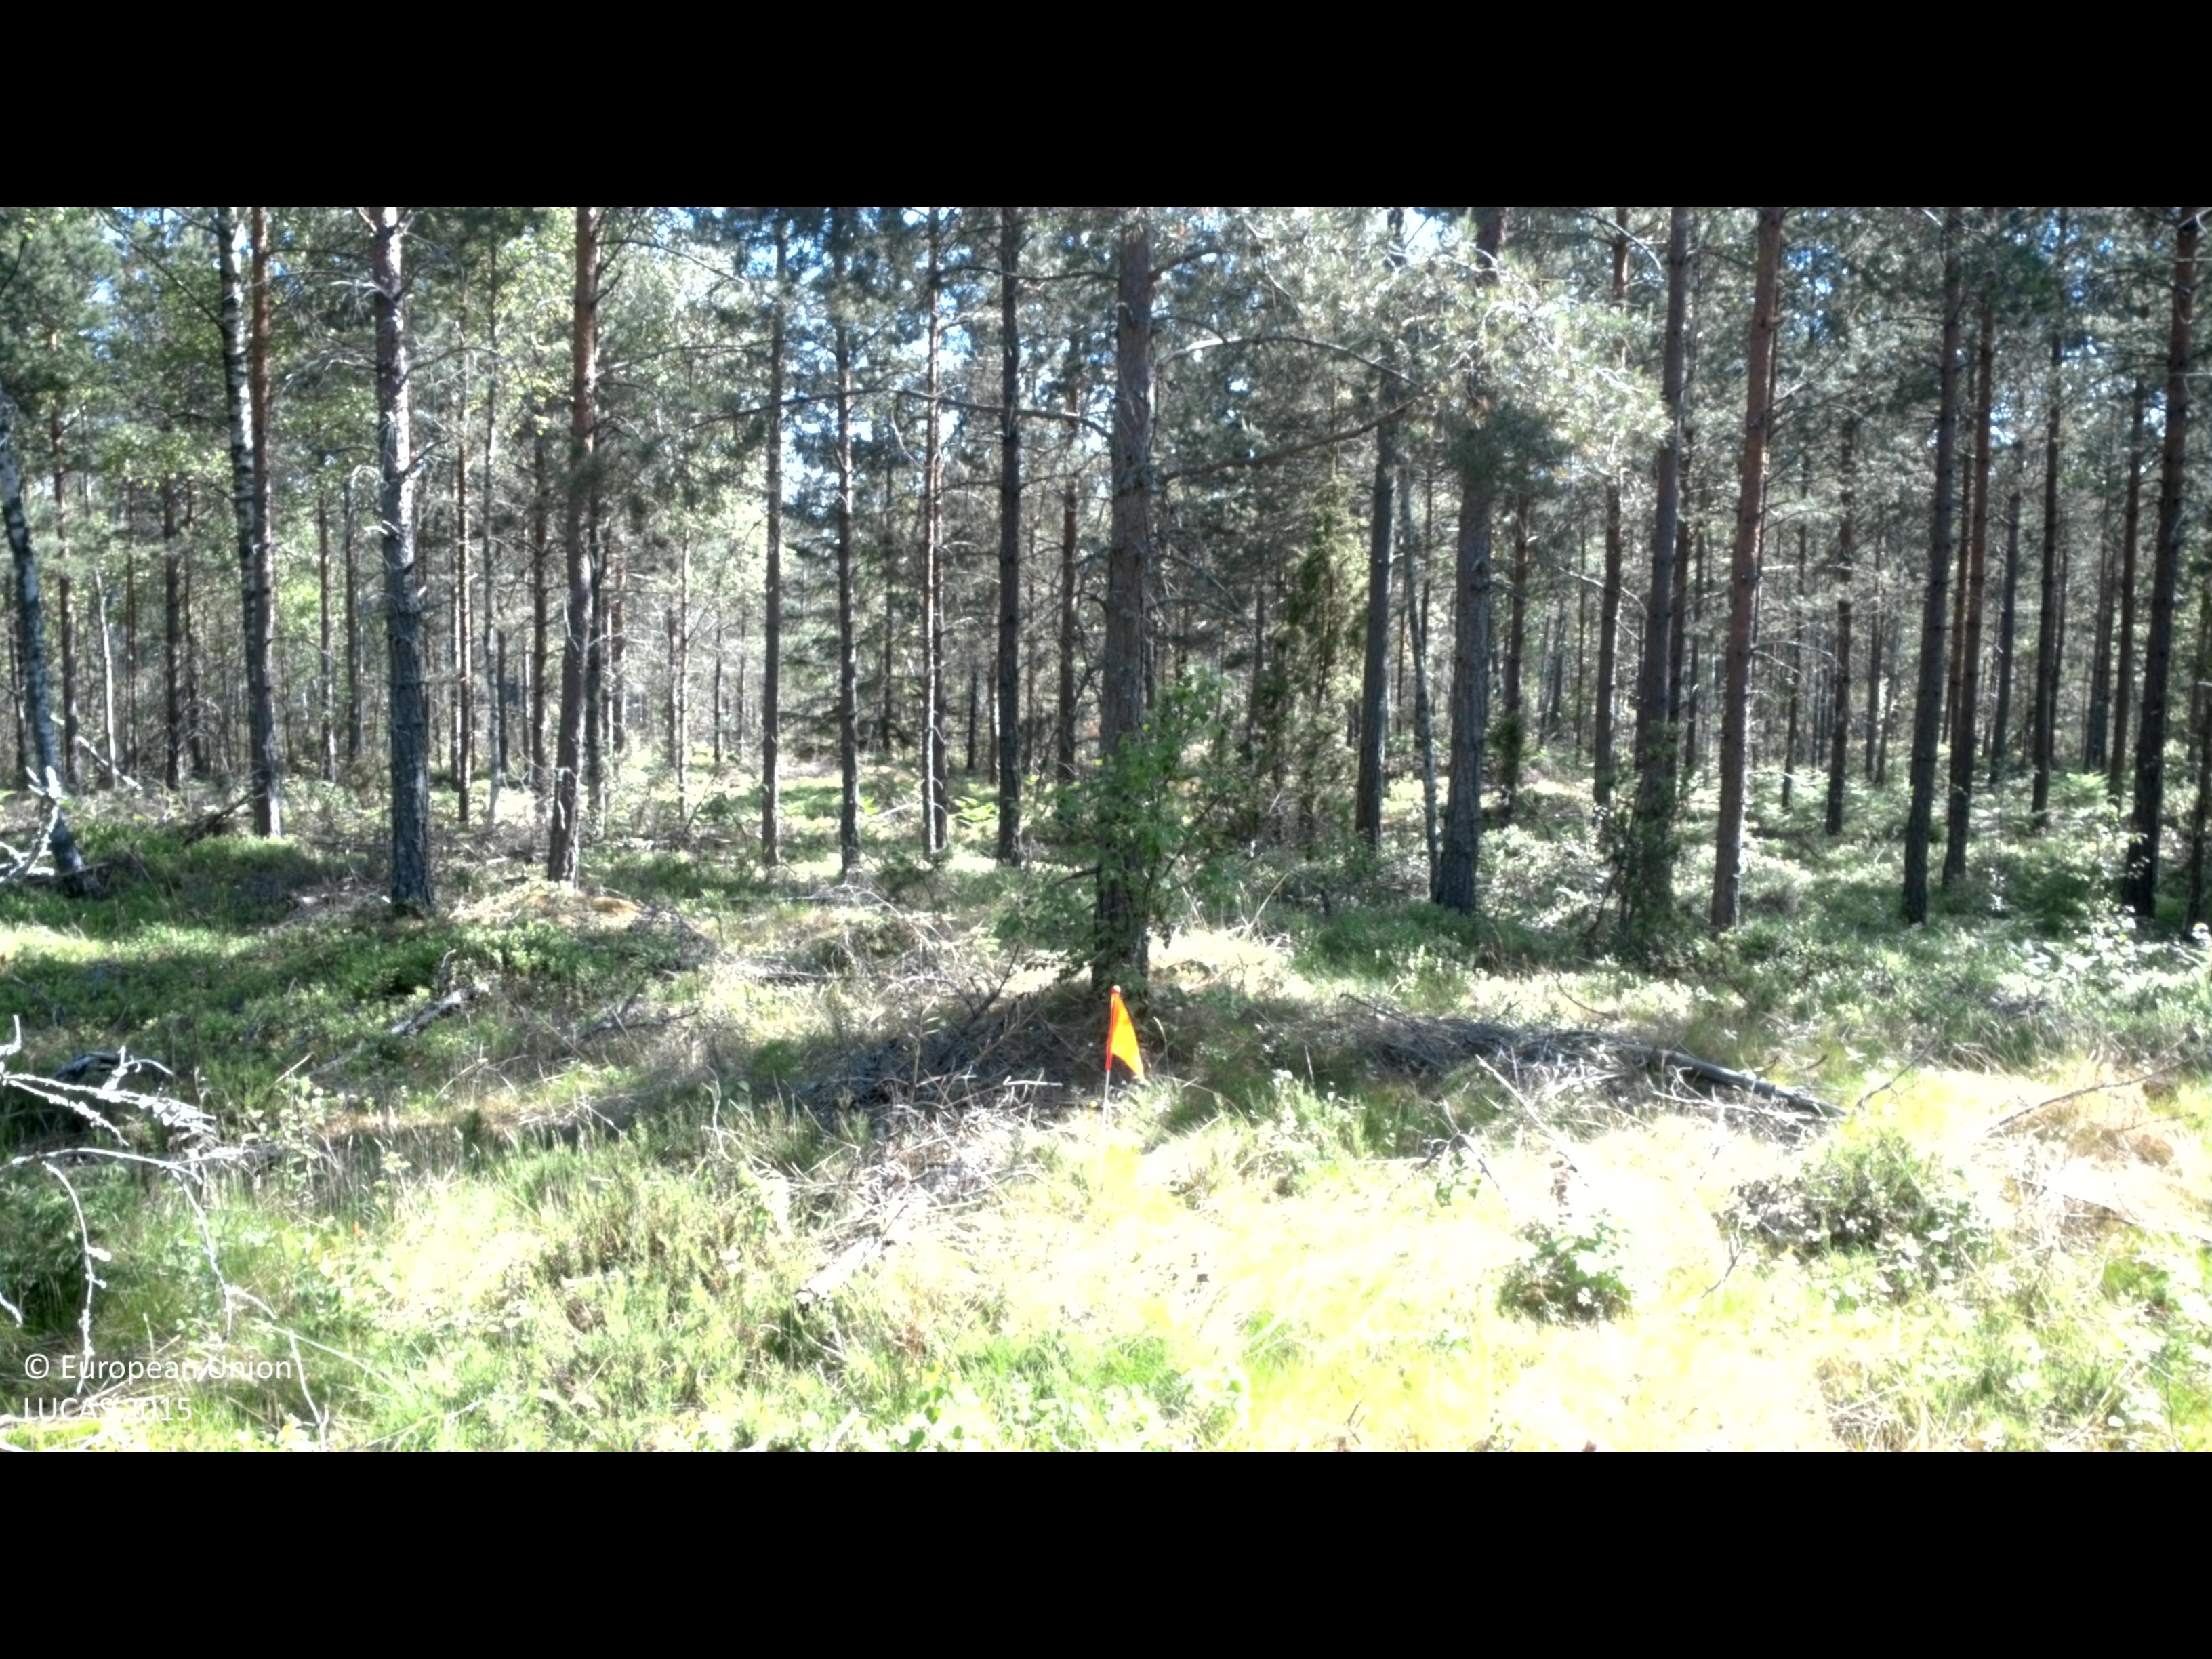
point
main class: Woodland
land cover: Pine dominated coniferous woodland
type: boreal forest
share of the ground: 50 - 75 %
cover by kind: coniferous forest trees 60 %, shrubs 20 %, herbaceous plants 10 %, broadleaved forest trees 5 %, lichens and mosses 5 %
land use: Forestry
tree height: > 5 m
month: June
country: SE
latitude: 57.6414
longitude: 16.6162
